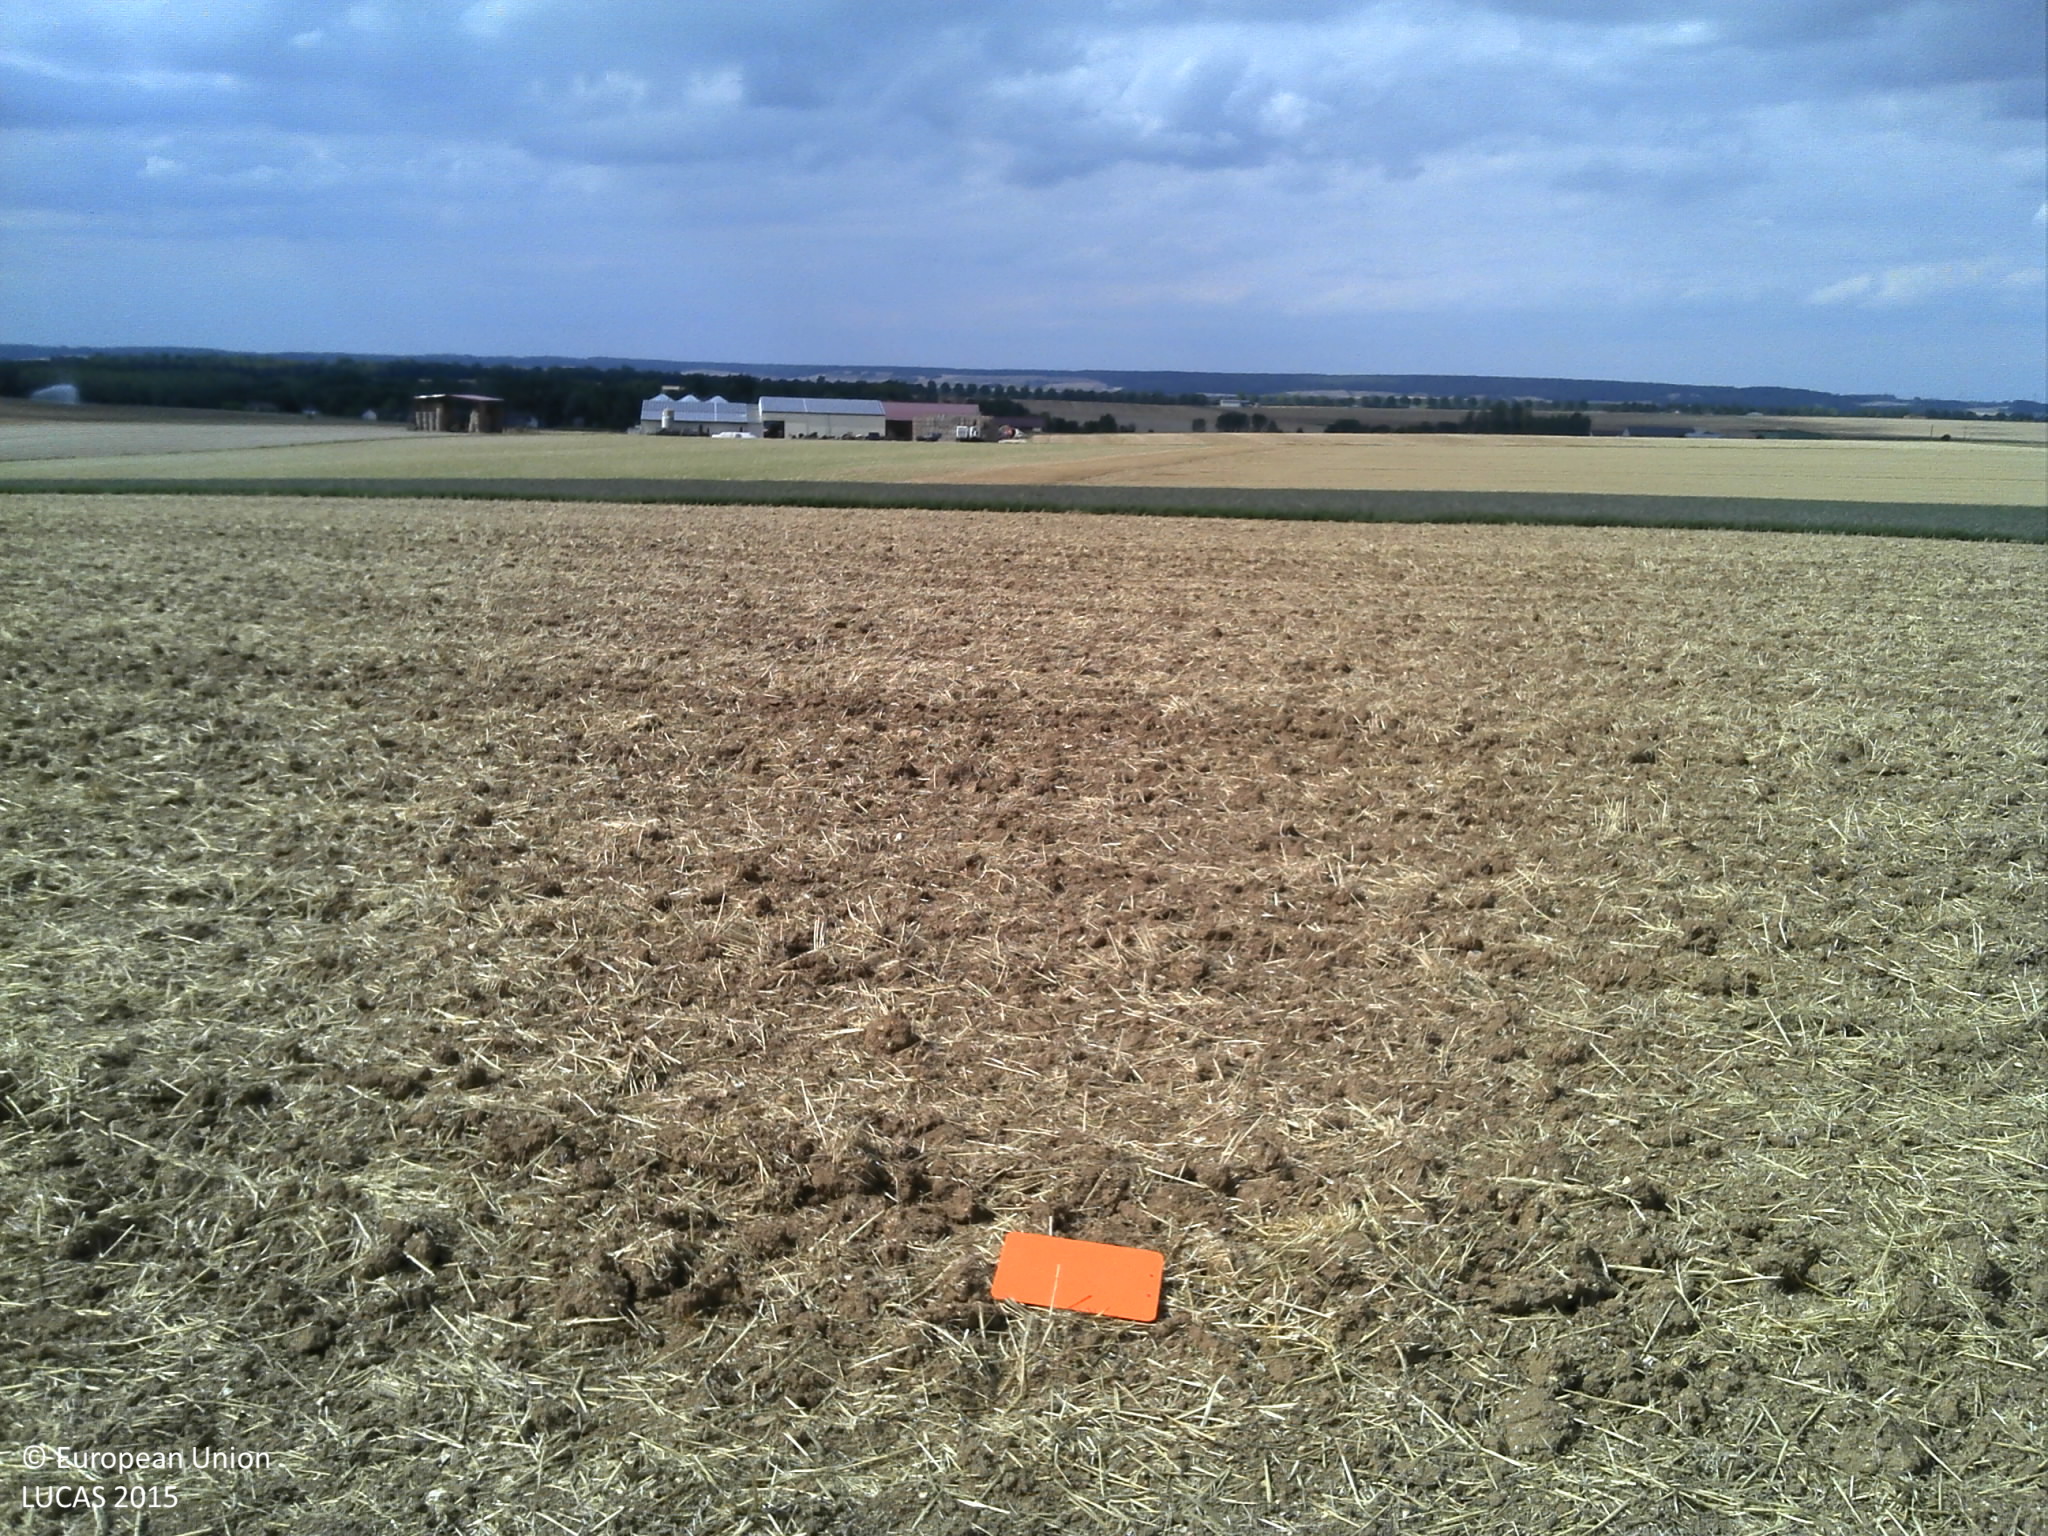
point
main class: Cropland
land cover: Common wheat
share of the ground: 25 - 50 %
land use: Agriculture (excluding fallow land and kitchen gardens)
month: August
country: FR
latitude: 48.4447
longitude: 3.4643
